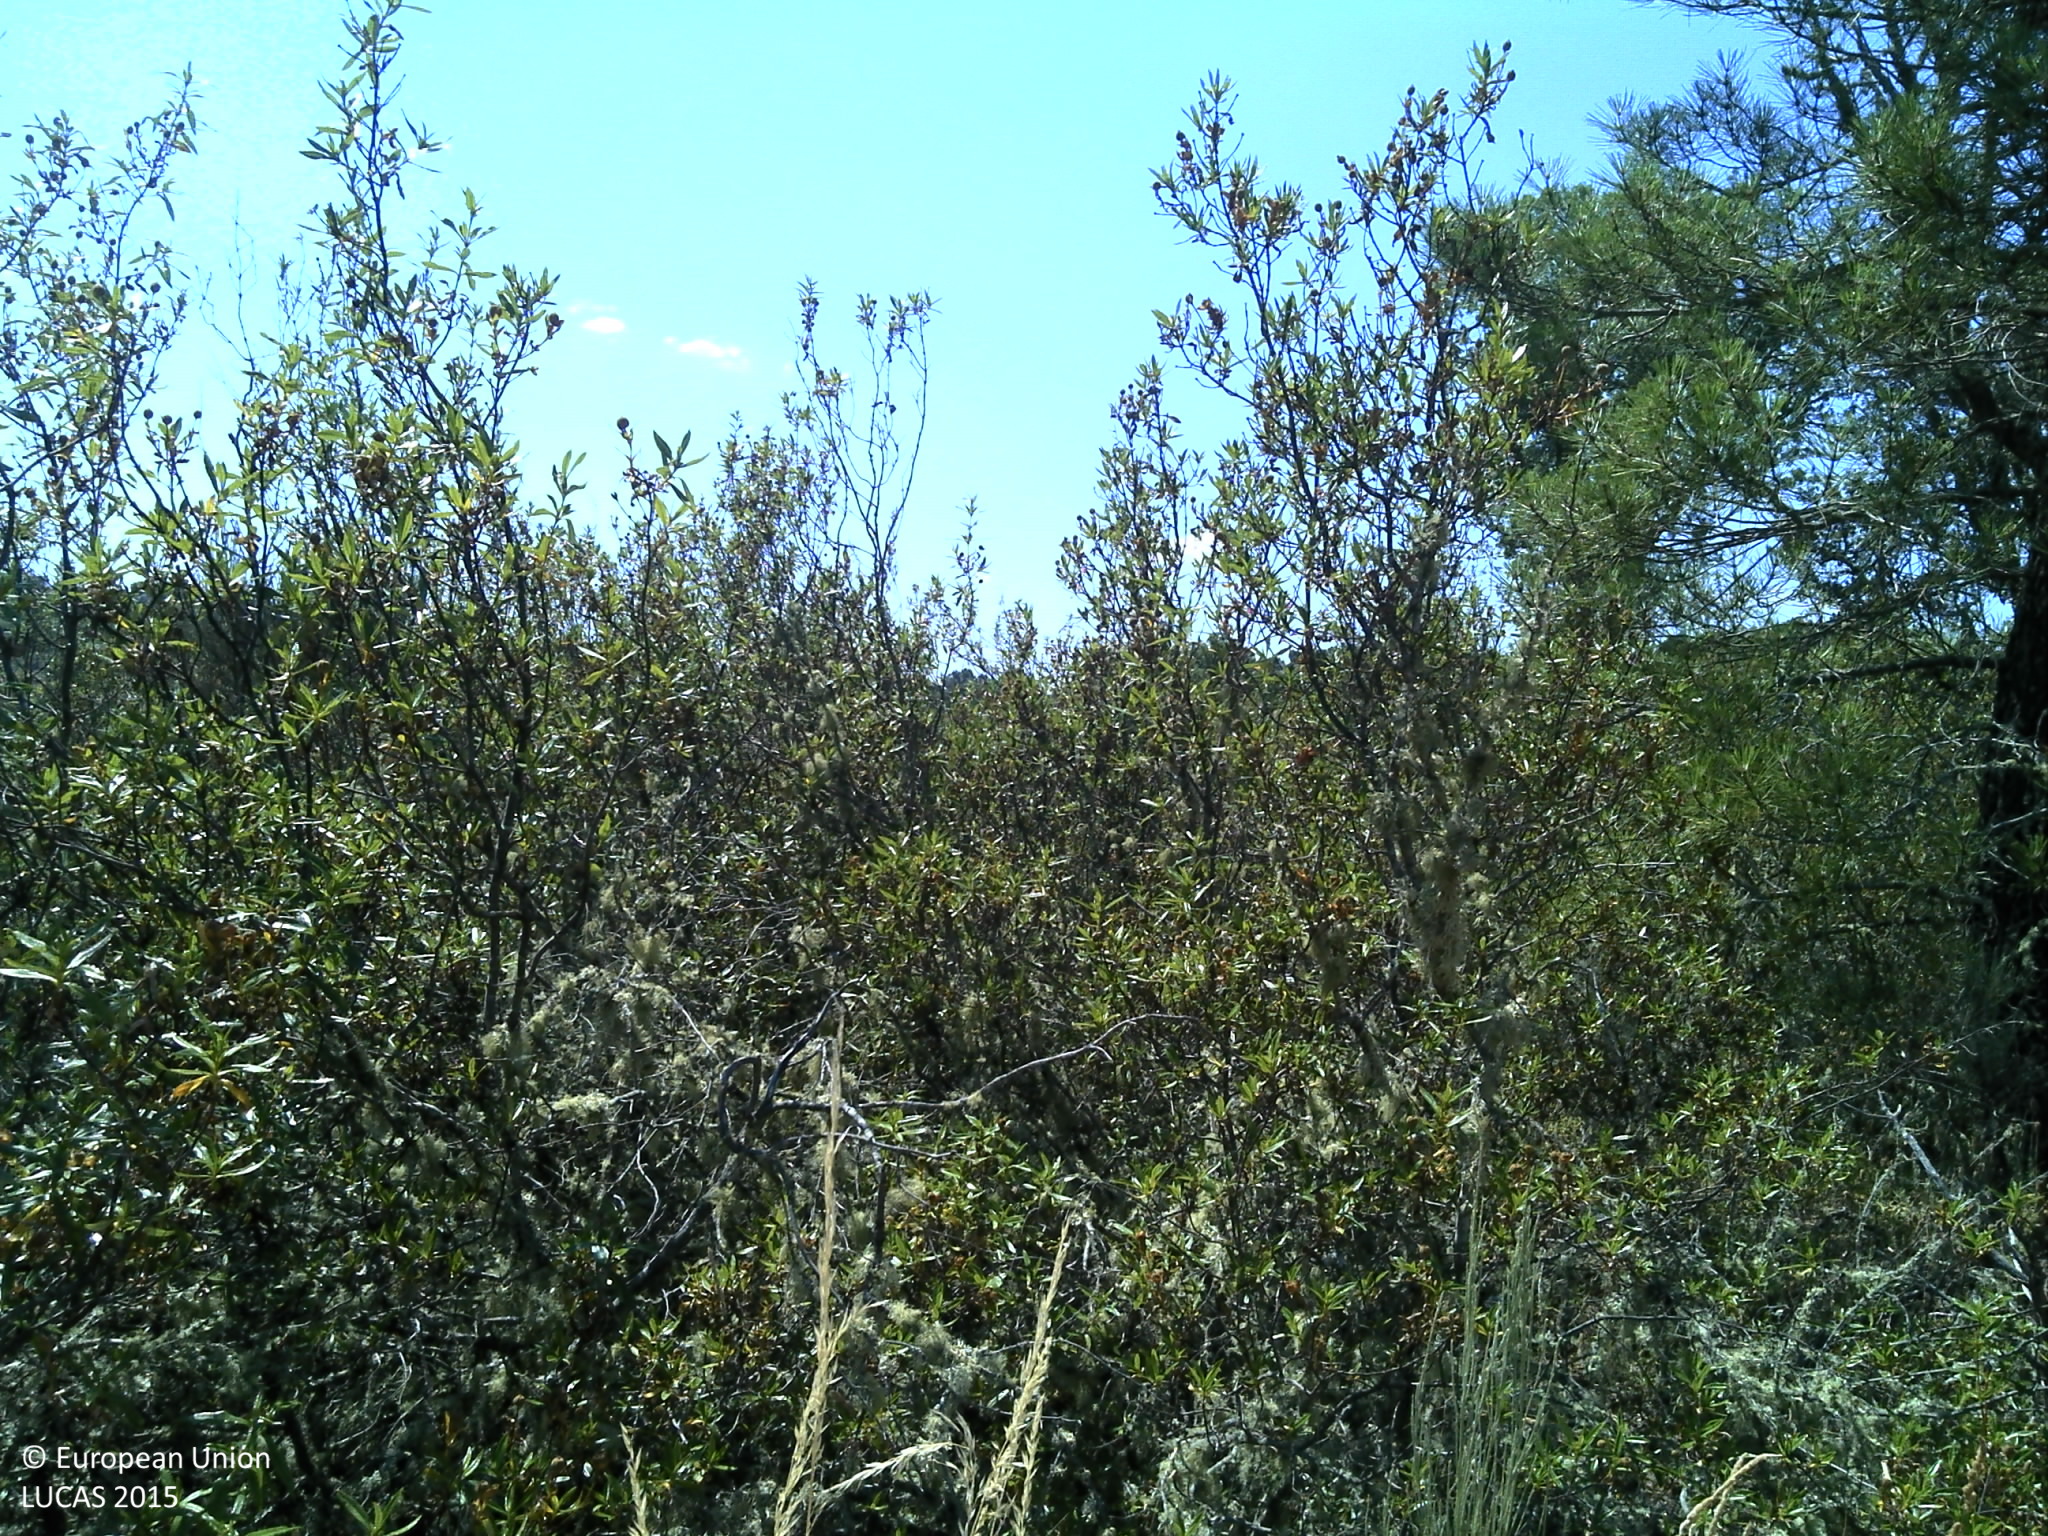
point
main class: Shrubland
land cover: Shrubland with sparse tree cover
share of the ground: > 75 %
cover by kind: shrubs 90 %, coniferous forest trees 5 %, unconsolidated bare surface 5 %
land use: Semi-natural and natural areas not in use
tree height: > 5 m
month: June
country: PT
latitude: 40.8246
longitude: -7.1706
